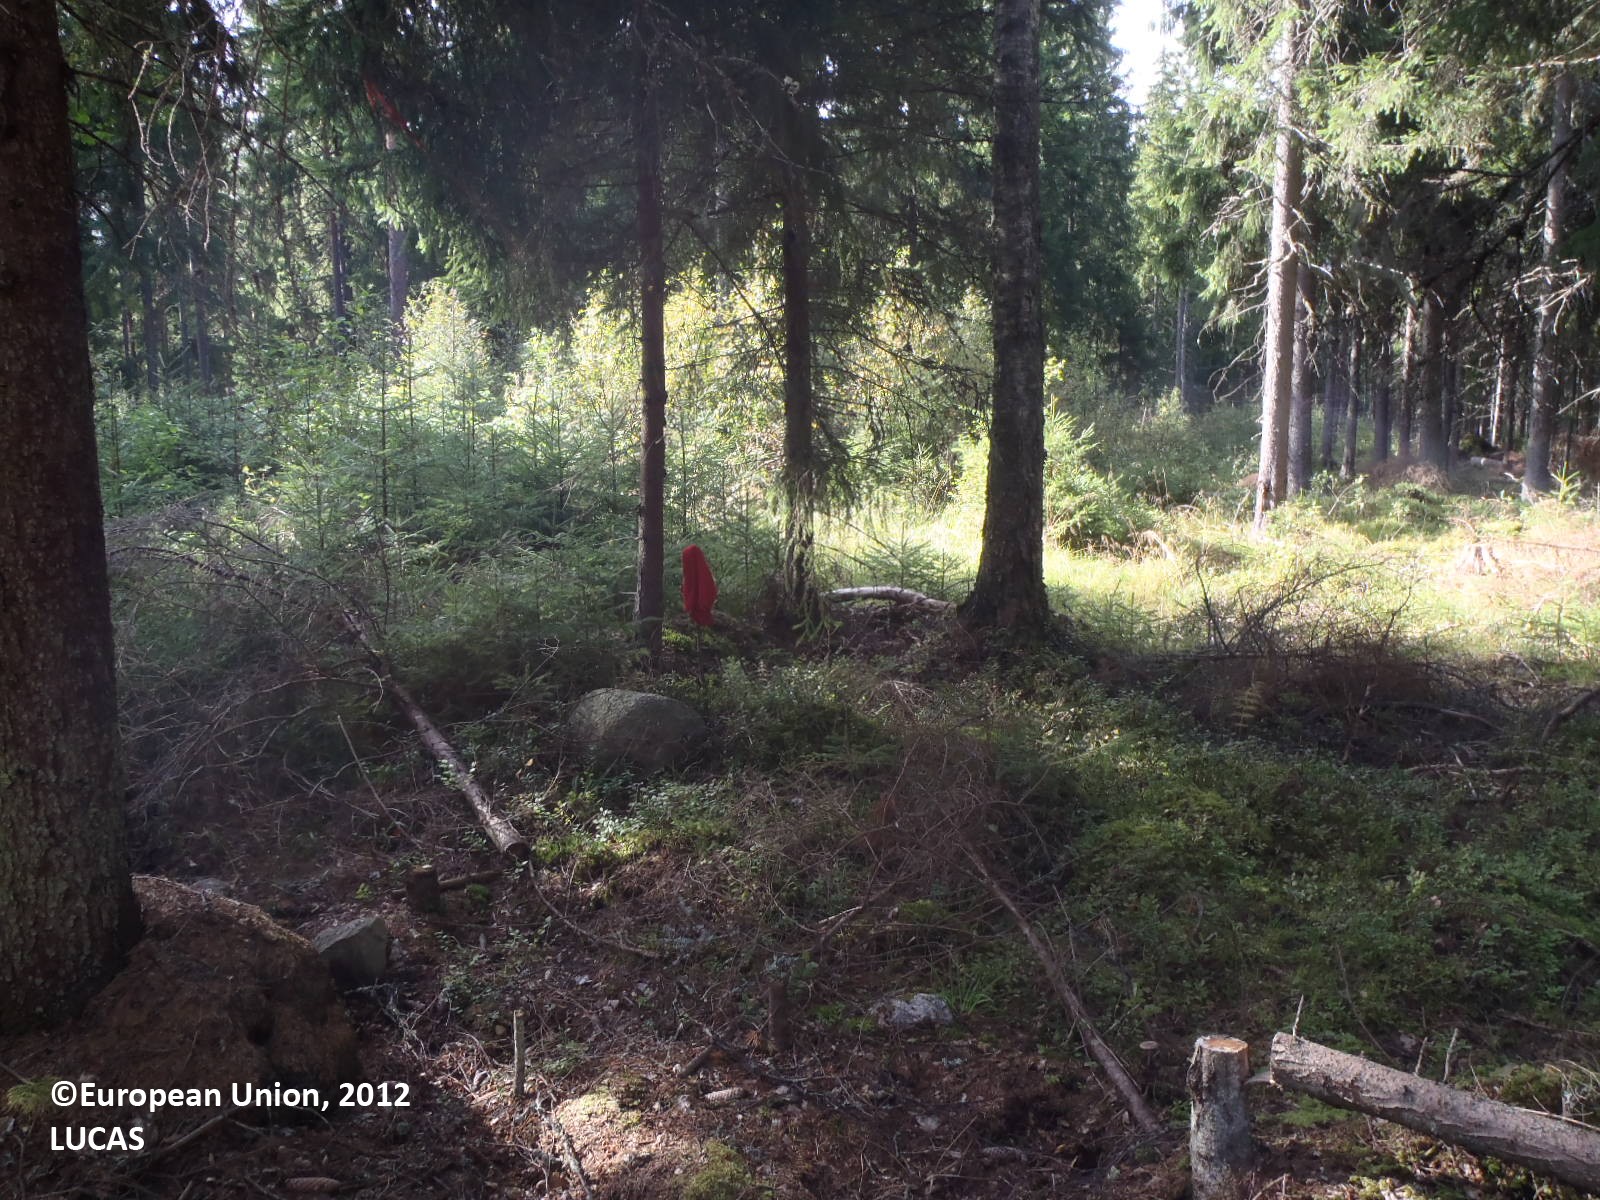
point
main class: Woodland
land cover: Spruce dominated coniferous woodland
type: boreal forest
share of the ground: > 75 %
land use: Forestry
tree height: > 5 m
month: September
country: FI
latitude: 61.1276
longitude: 22.4107
